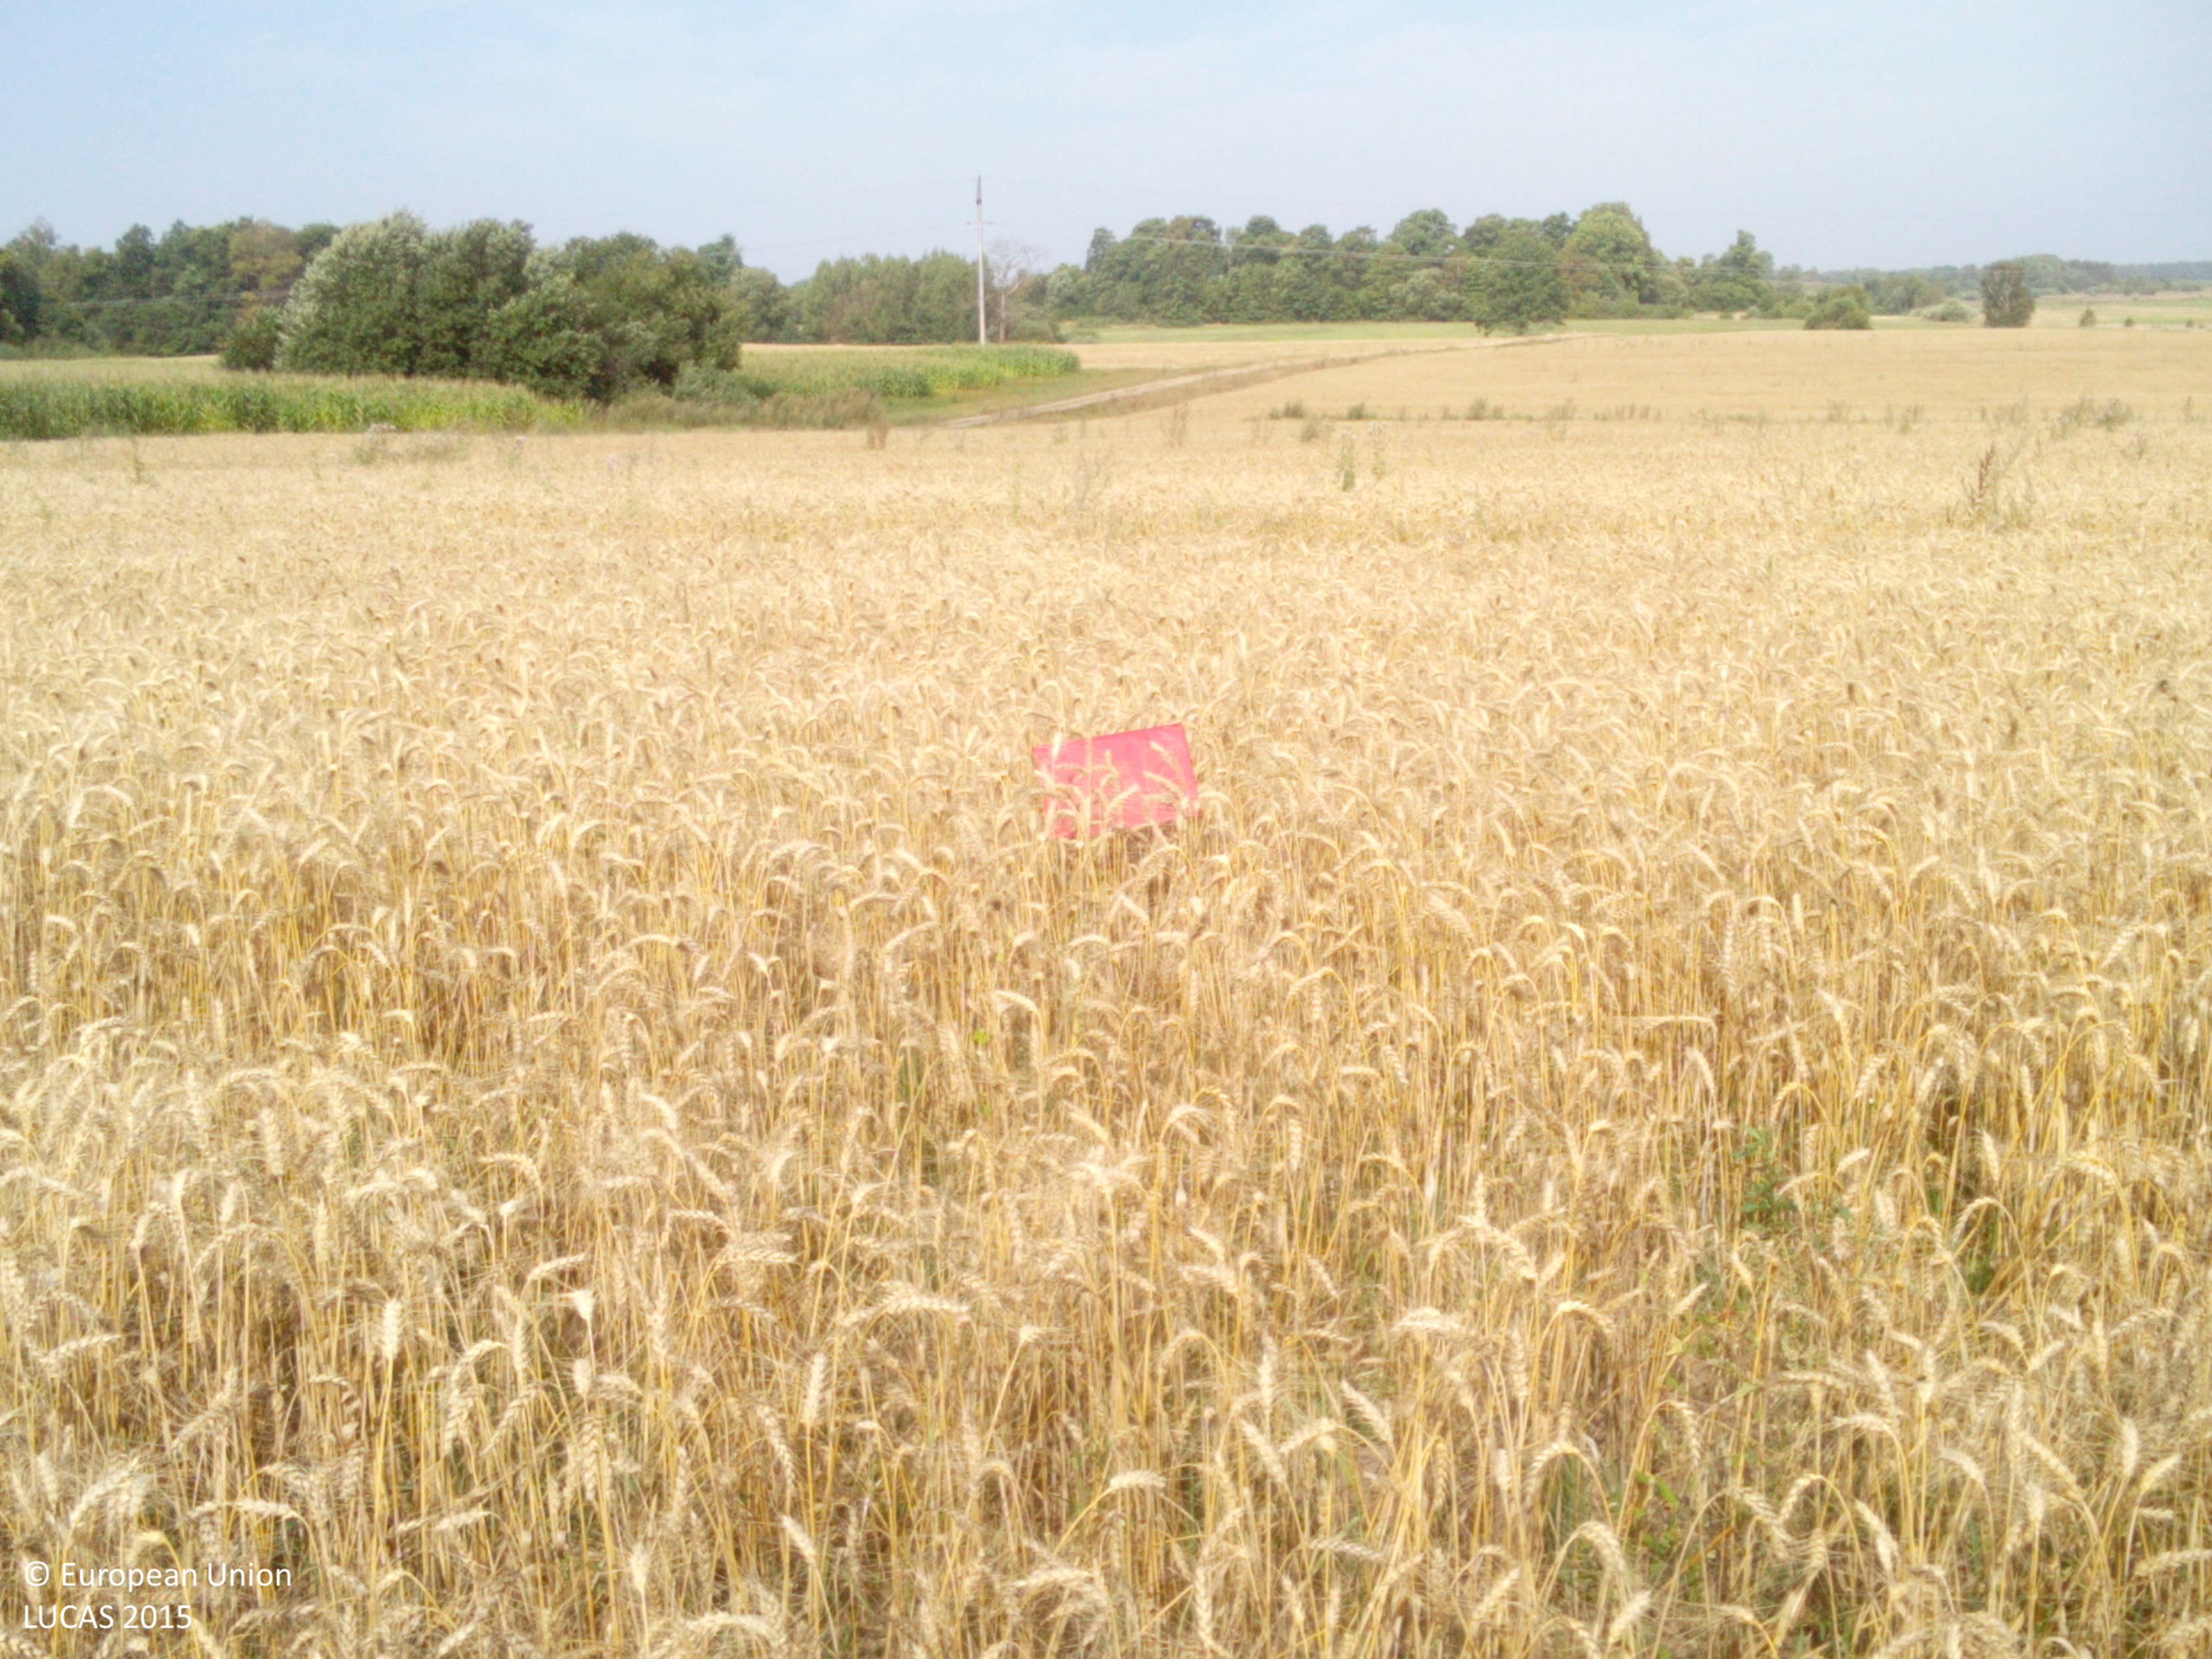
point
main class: Cropland
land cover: Common wheat
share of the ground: > 75 %
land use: Agriculture (excluding fallow land and kitchen gardens)
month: August
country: LV
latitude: 56.1803
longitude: 21.2690
